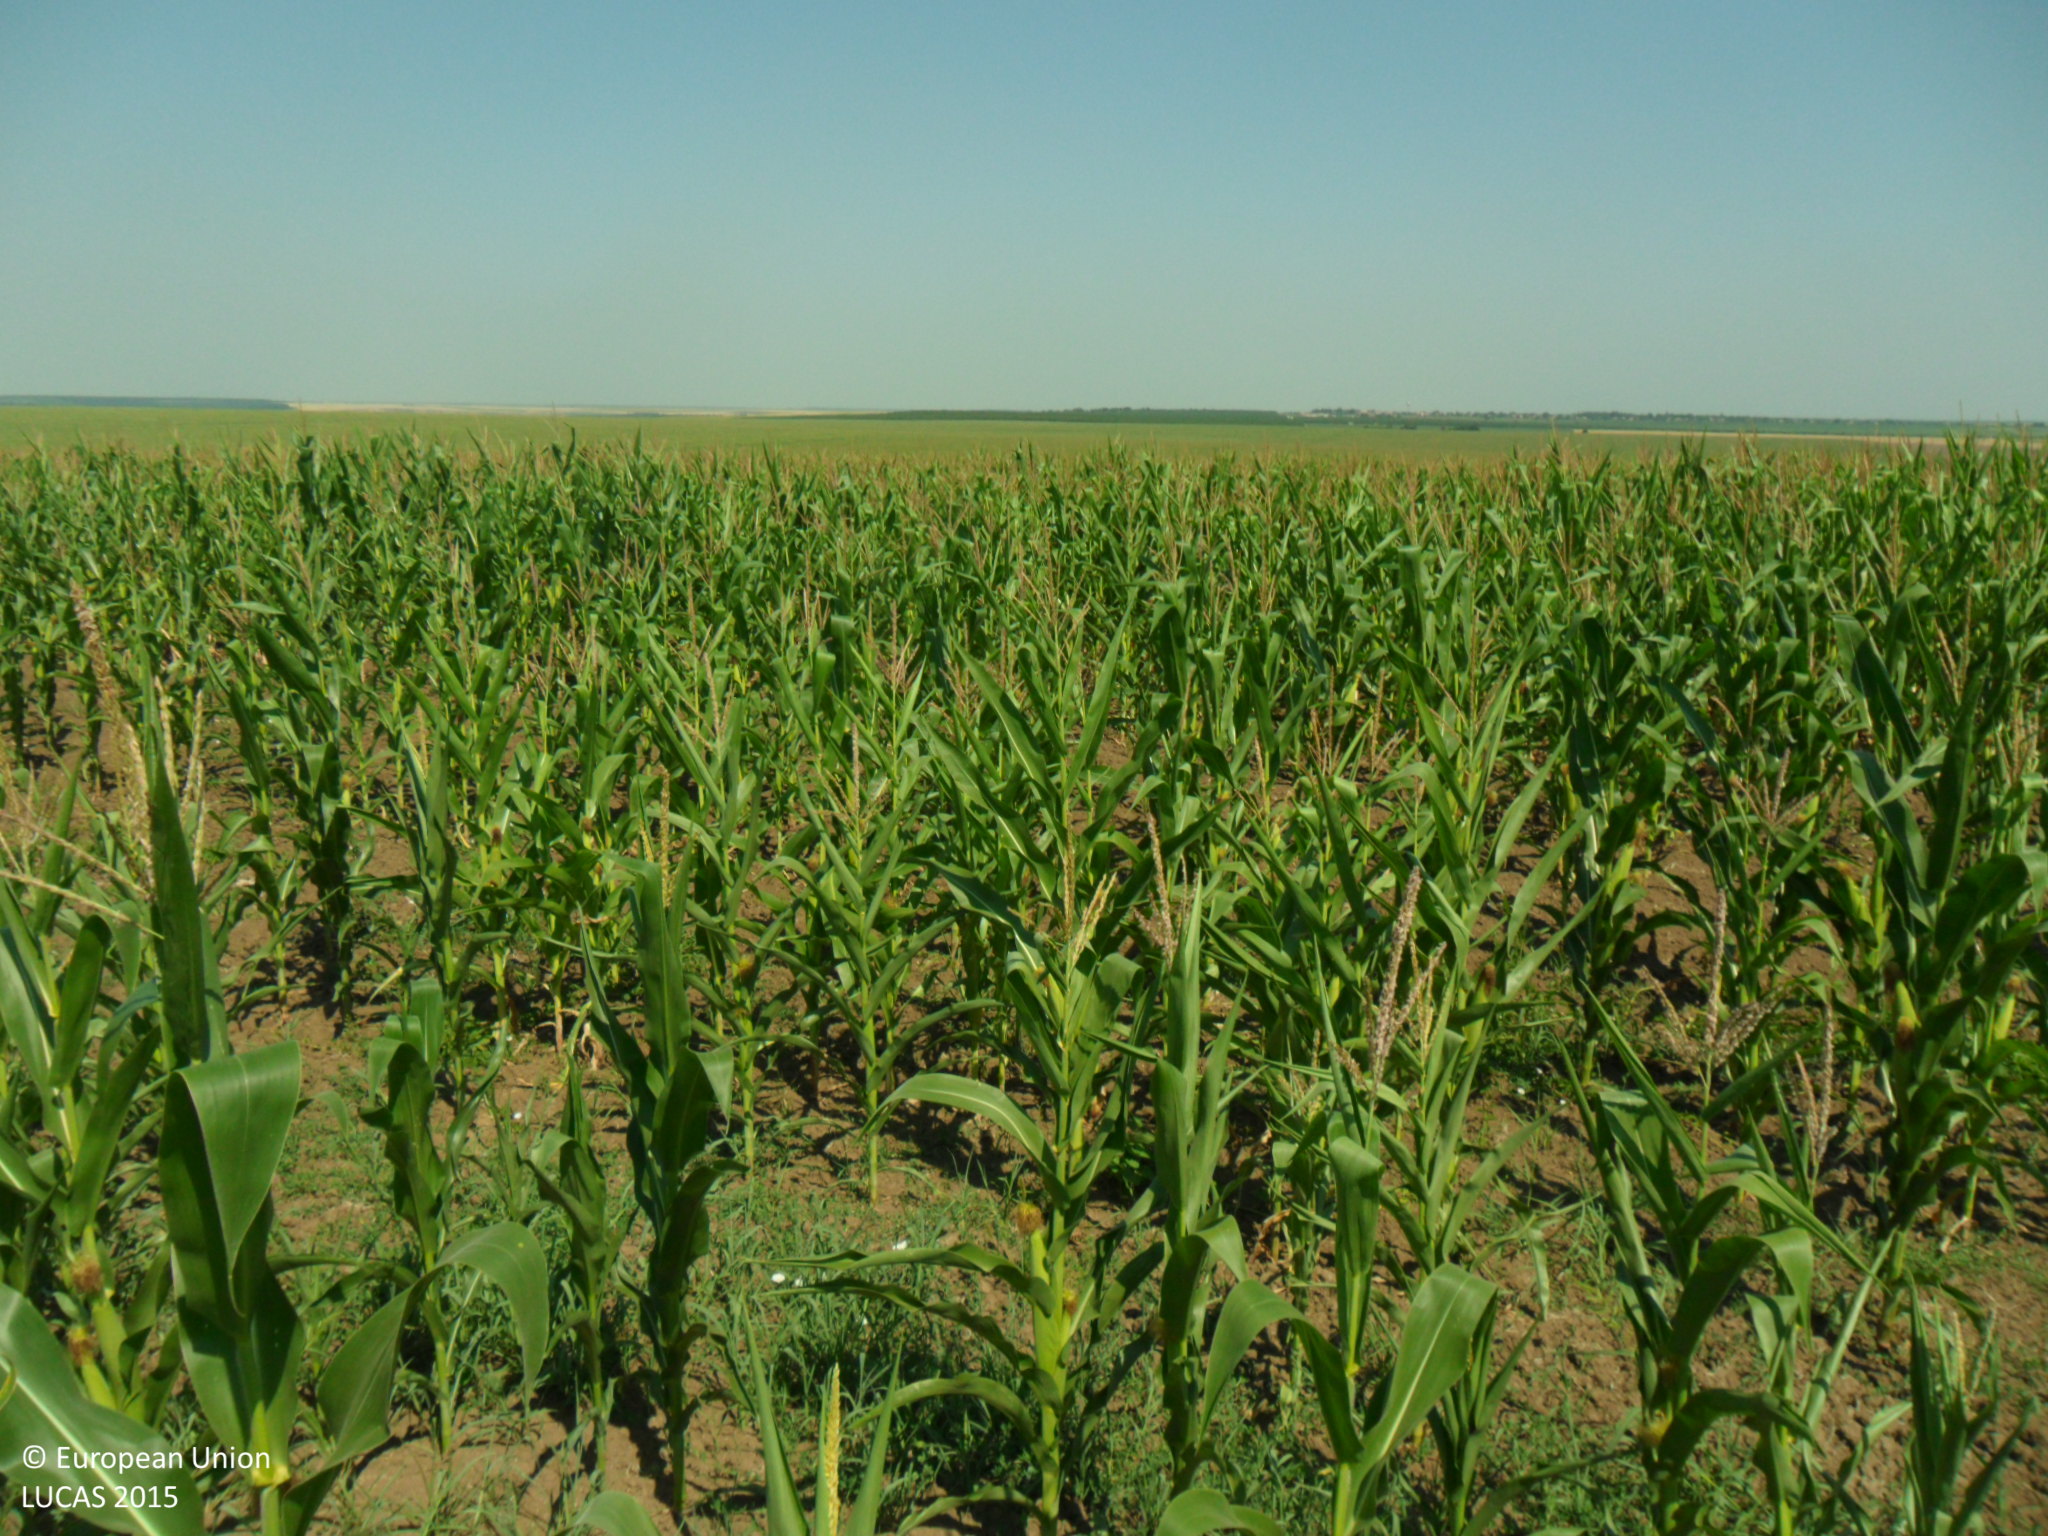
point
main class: Cropland
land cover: Maize
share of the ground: > 75 %
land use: Agriculture (excluding fallow land and kitchen gardens)
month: July
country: BG
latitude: 43.6005
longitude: 27.3092
